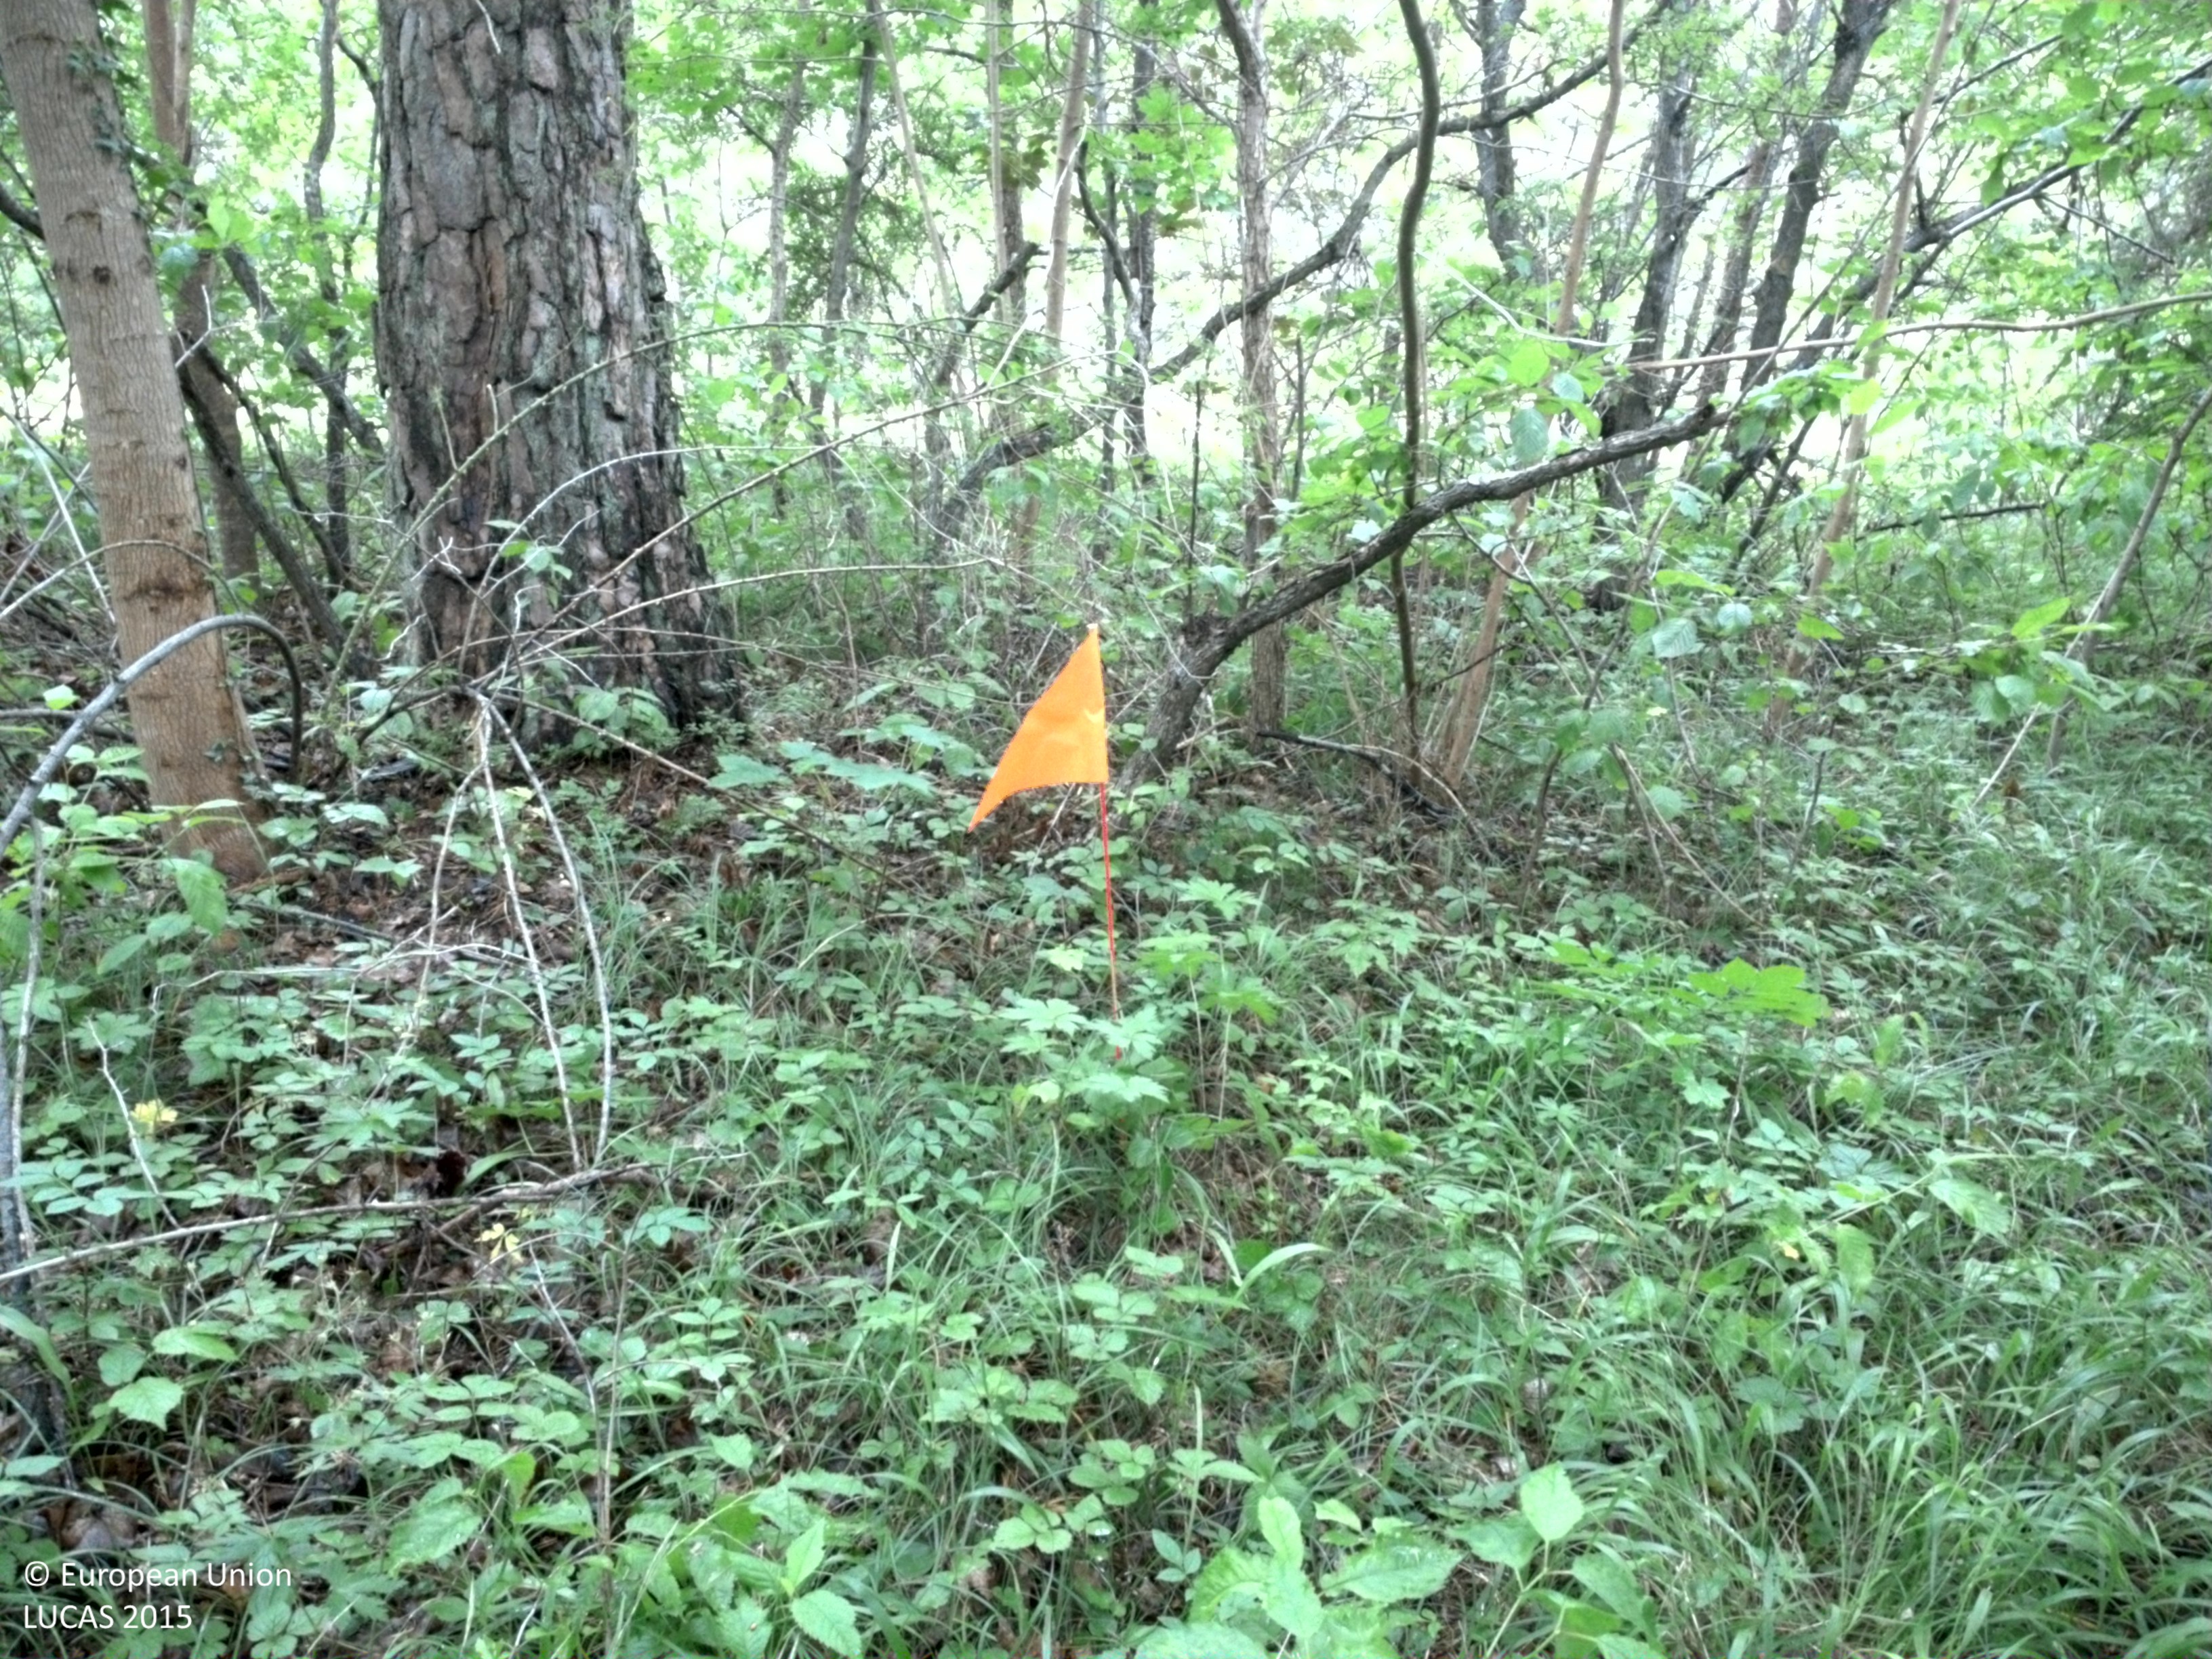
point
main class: Woodland
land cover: Pine dominated mixed woodland
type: hemiboreal forest and nemoral coniferous forest and mixed broadleaved-coniferous forest
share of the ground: > 75 %
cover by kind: coniferous forest trees 45 %, broadleaved forest trees 35 %, herbaceous plants 15 %, shrubs 5 %
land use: Forestry
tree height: > 5 m
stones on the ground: < 10 %
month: July
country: SE
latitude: 57.6035
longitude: 18.2569
